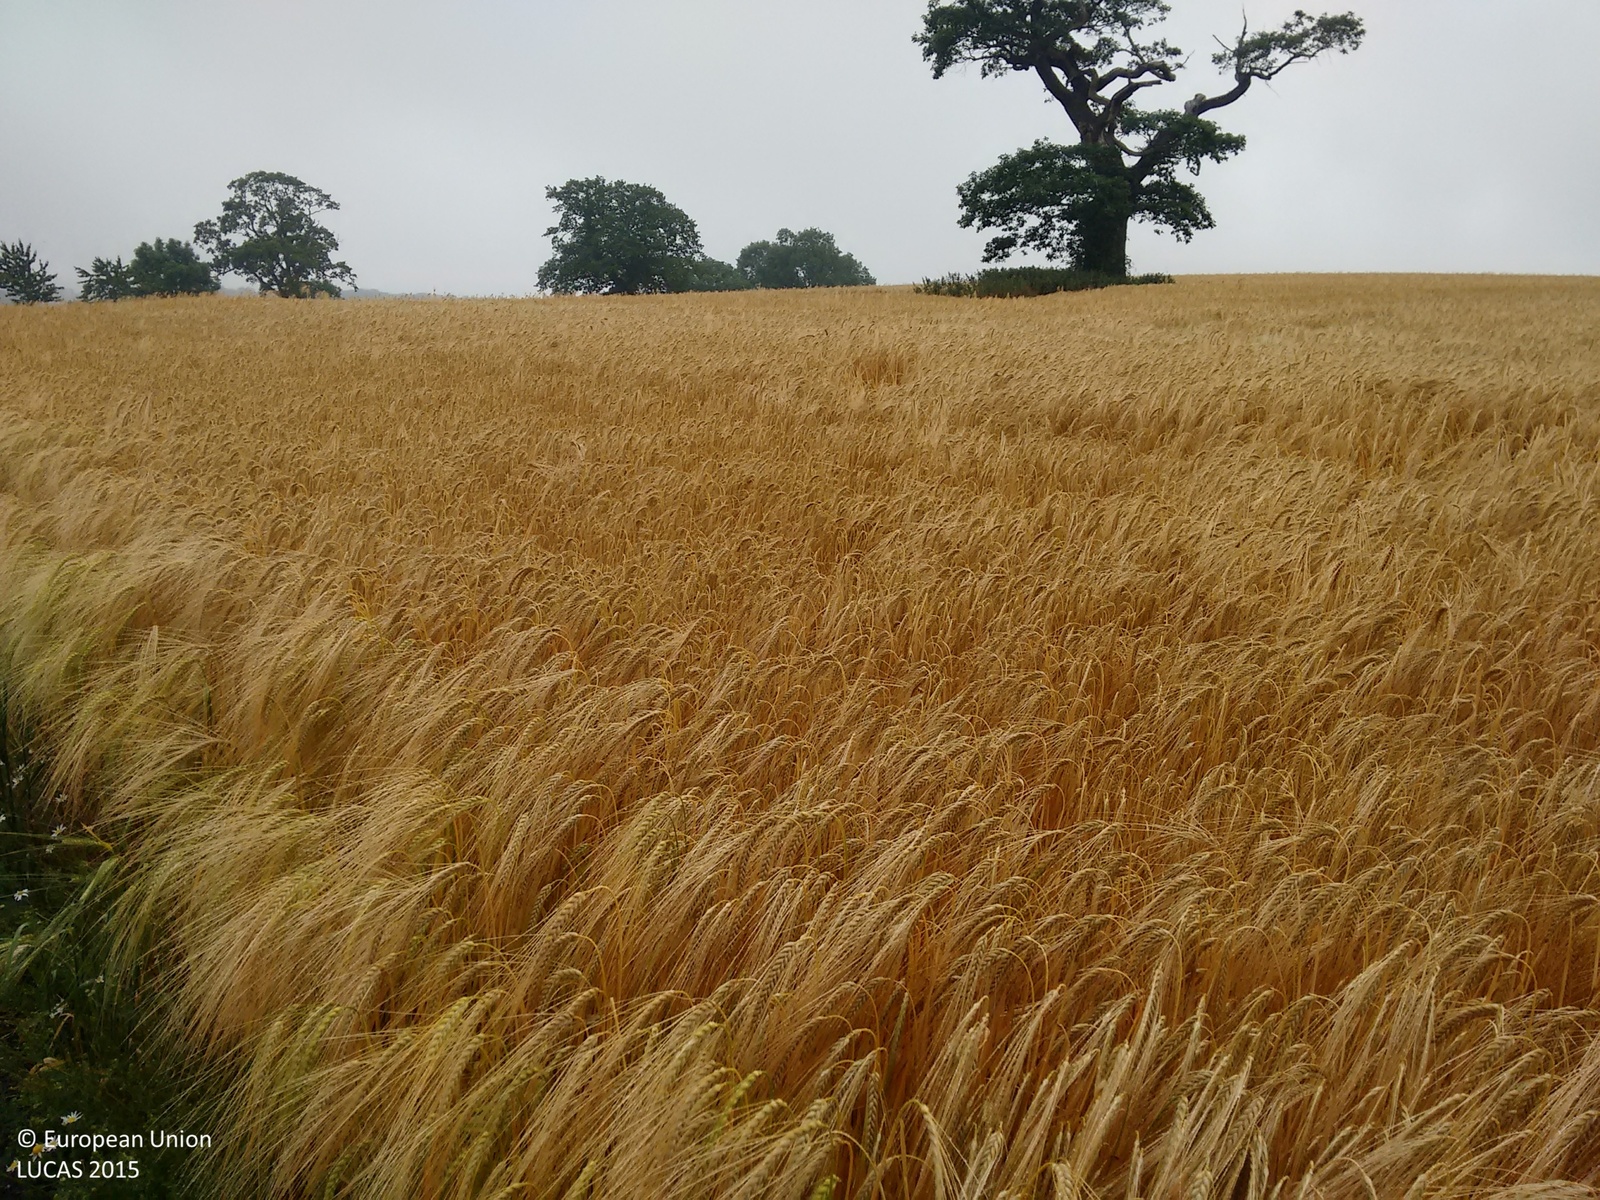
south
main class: Cropland
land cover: Barley
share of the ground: > 75 %
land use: Agriculture (excluding fallow land and kitchen gardens)
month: July
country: GB
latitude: 52.3691
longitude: -2.8352
